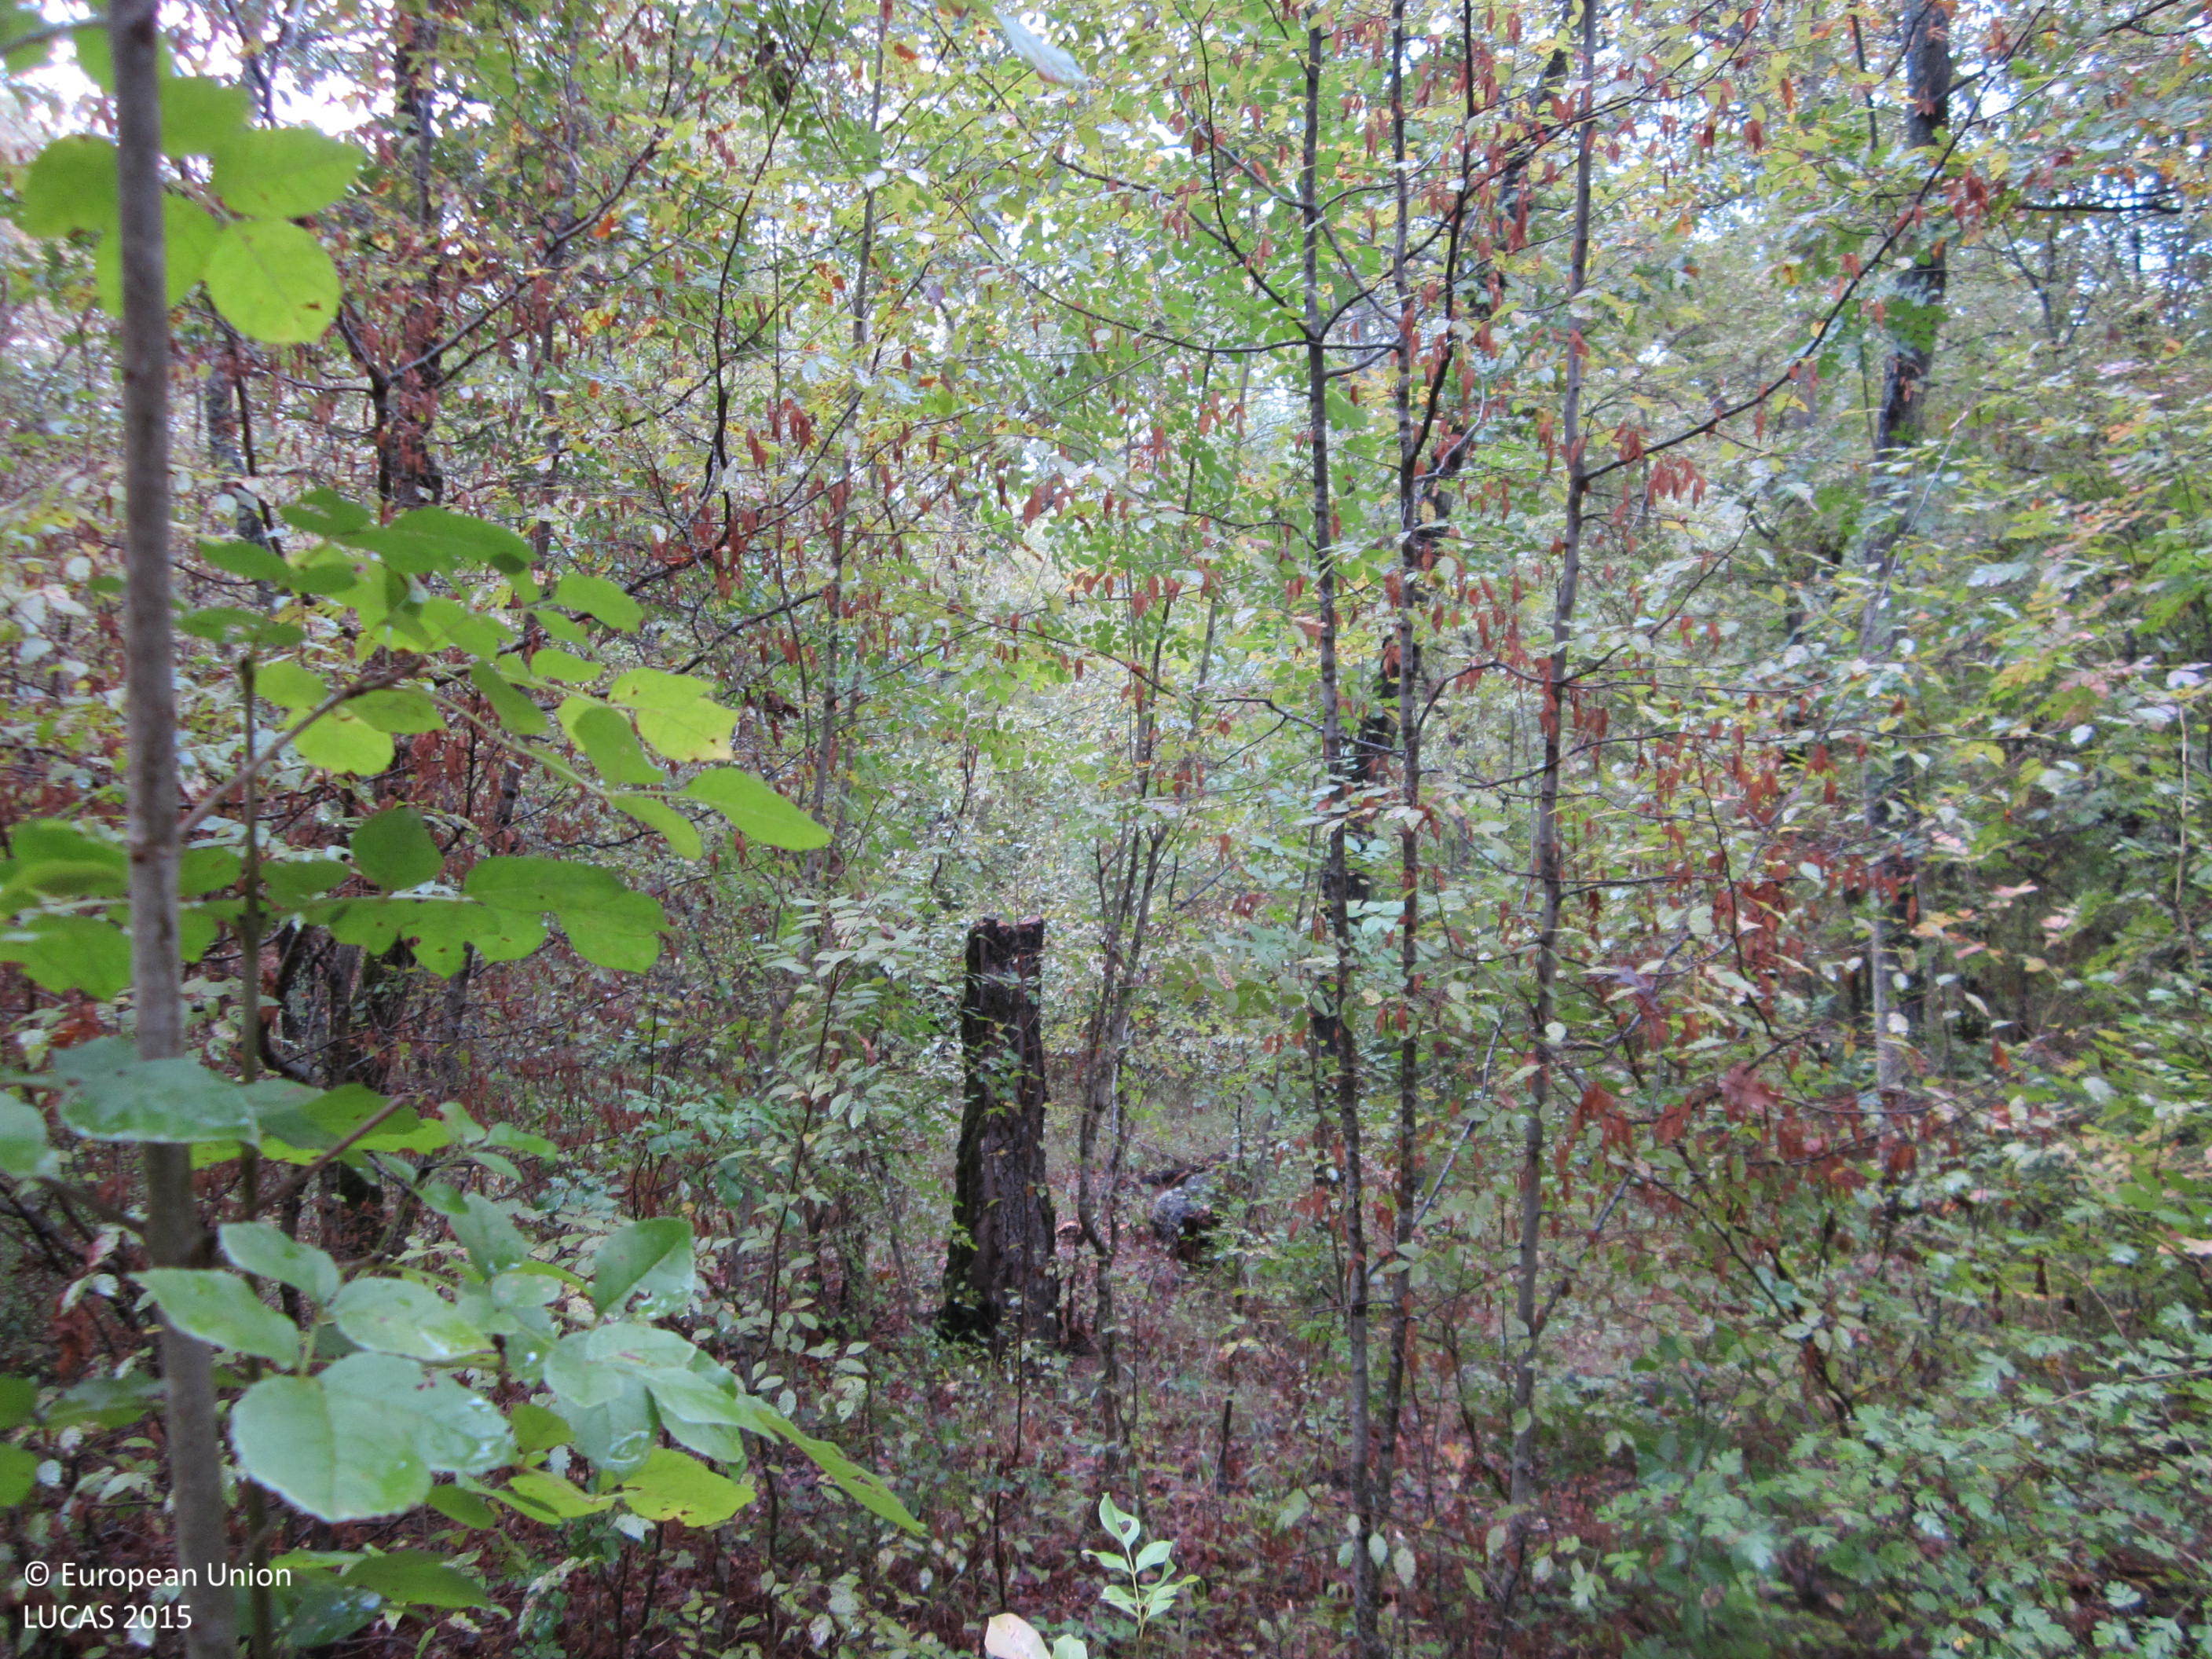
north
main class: Woodland
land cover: Broadleaved woodland
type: mesophytic deciduous forest
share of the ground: > 75 %
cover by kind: broadleaved forest trees 80 %, shrubs 10 %, herbaceous plants 10 %
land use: Forestry
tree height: > 5 m
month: October
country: BG
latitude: 42.3156
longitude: 27.1777
